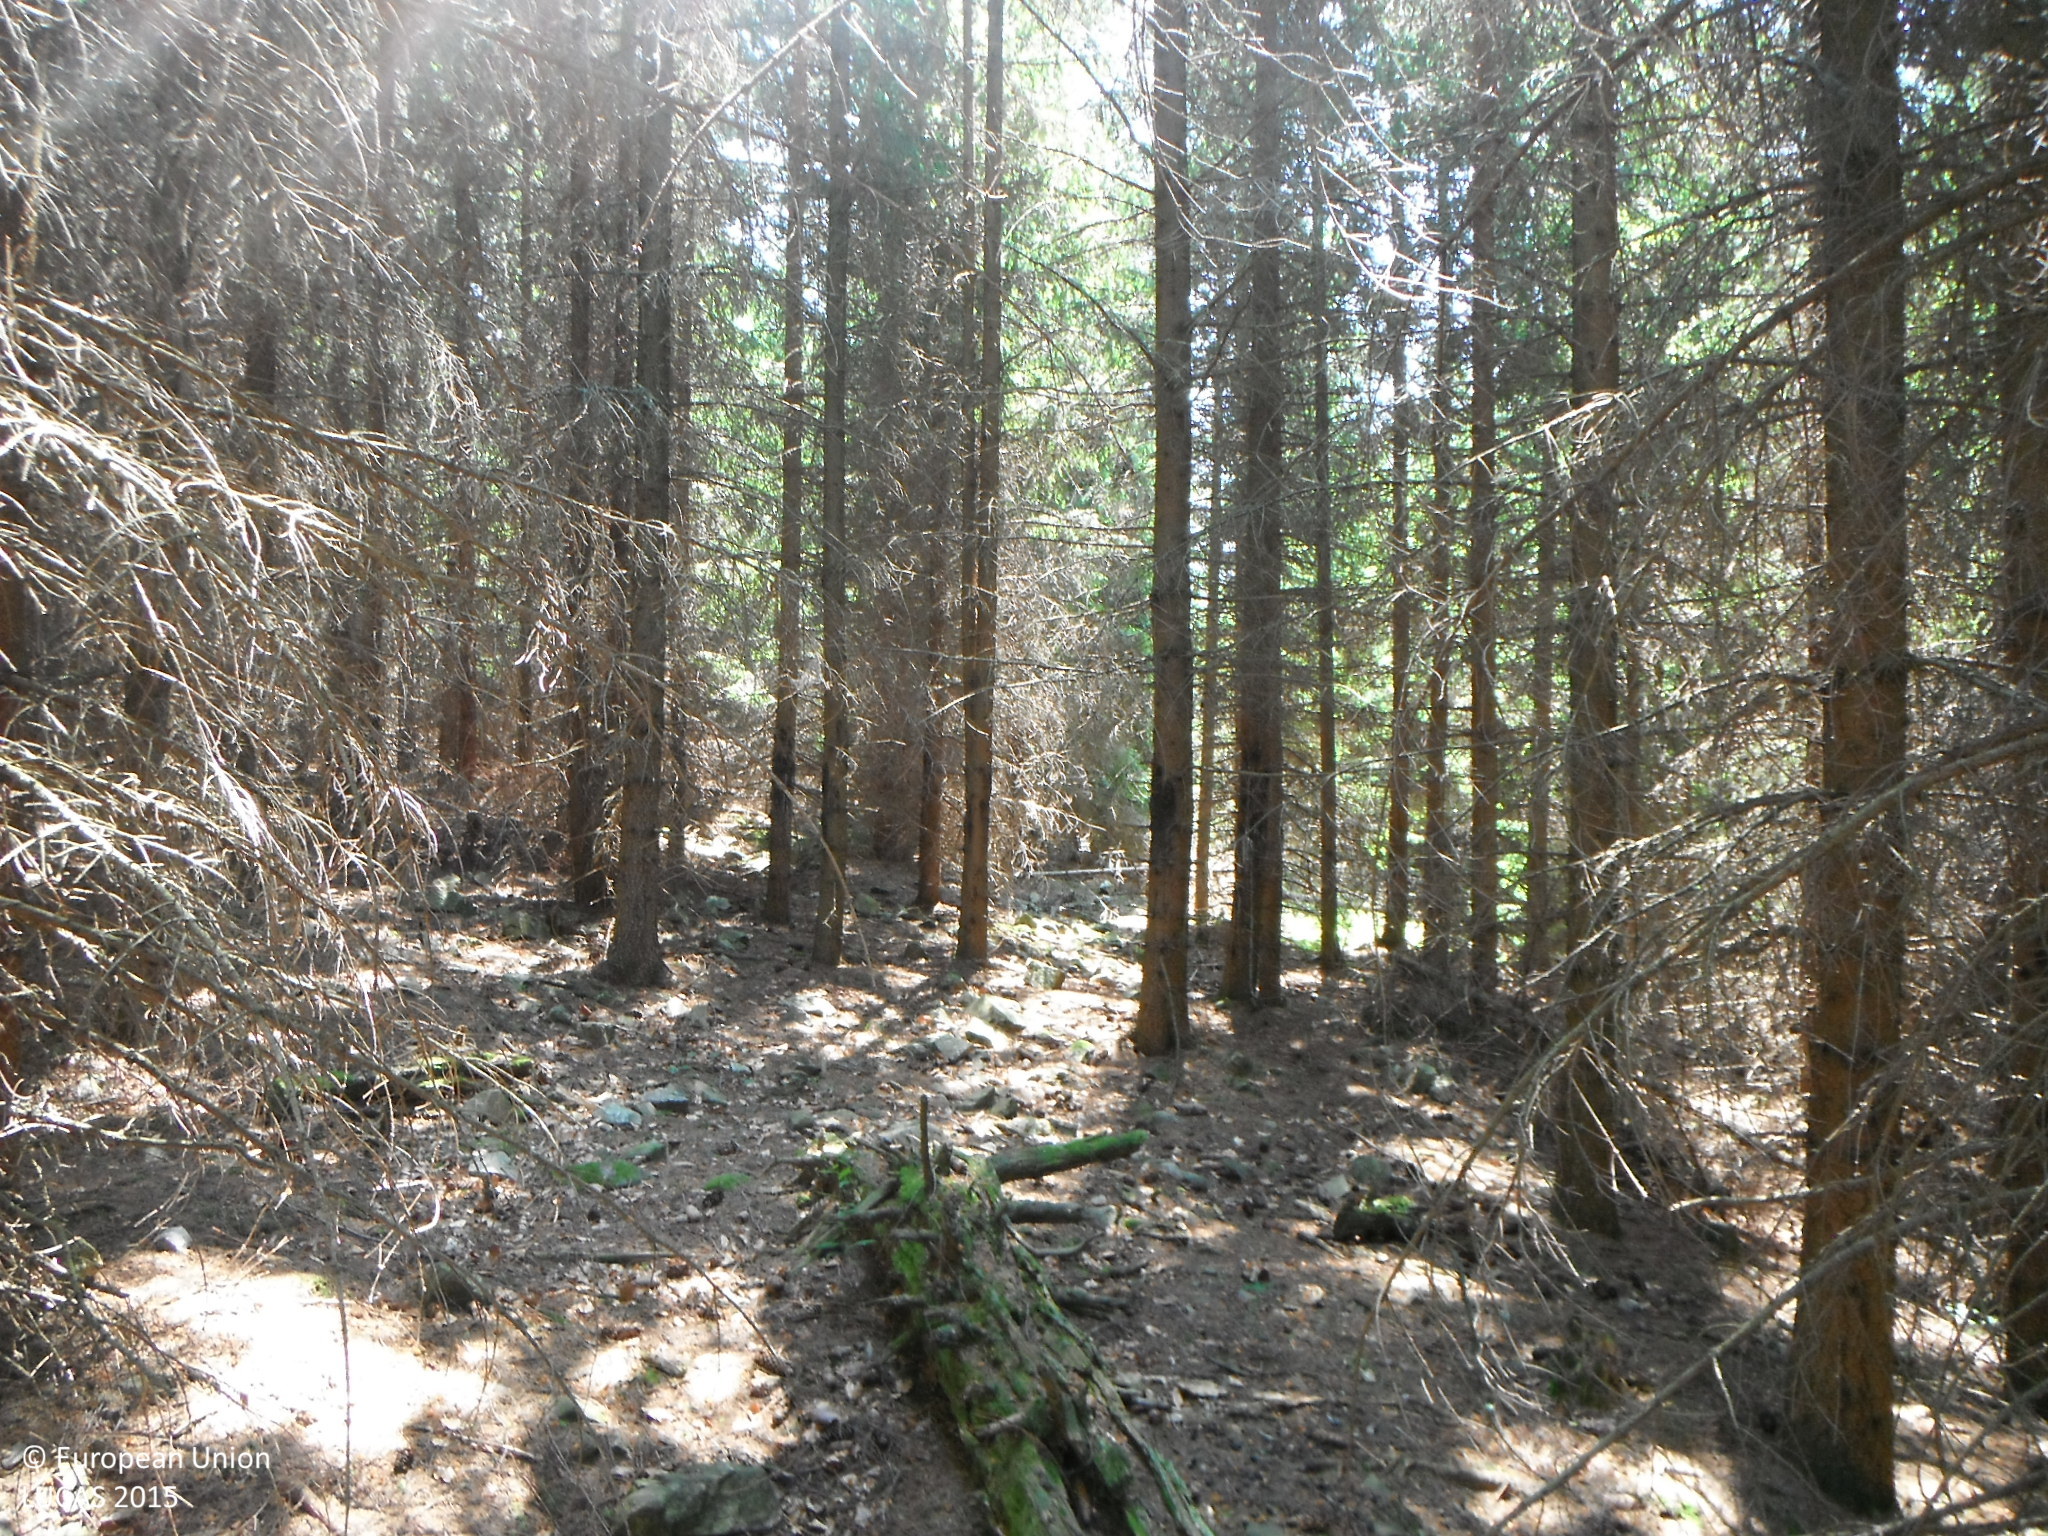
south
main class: Woodland
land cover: Spruce dominated coniferous woodland
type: alpine coniferous forest
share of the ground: > 75 %
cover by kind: coniferous forest trees 100 %
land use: Forestry
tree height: > 5 m
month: June
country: SK
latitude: 48.7142
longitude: 19.3338
